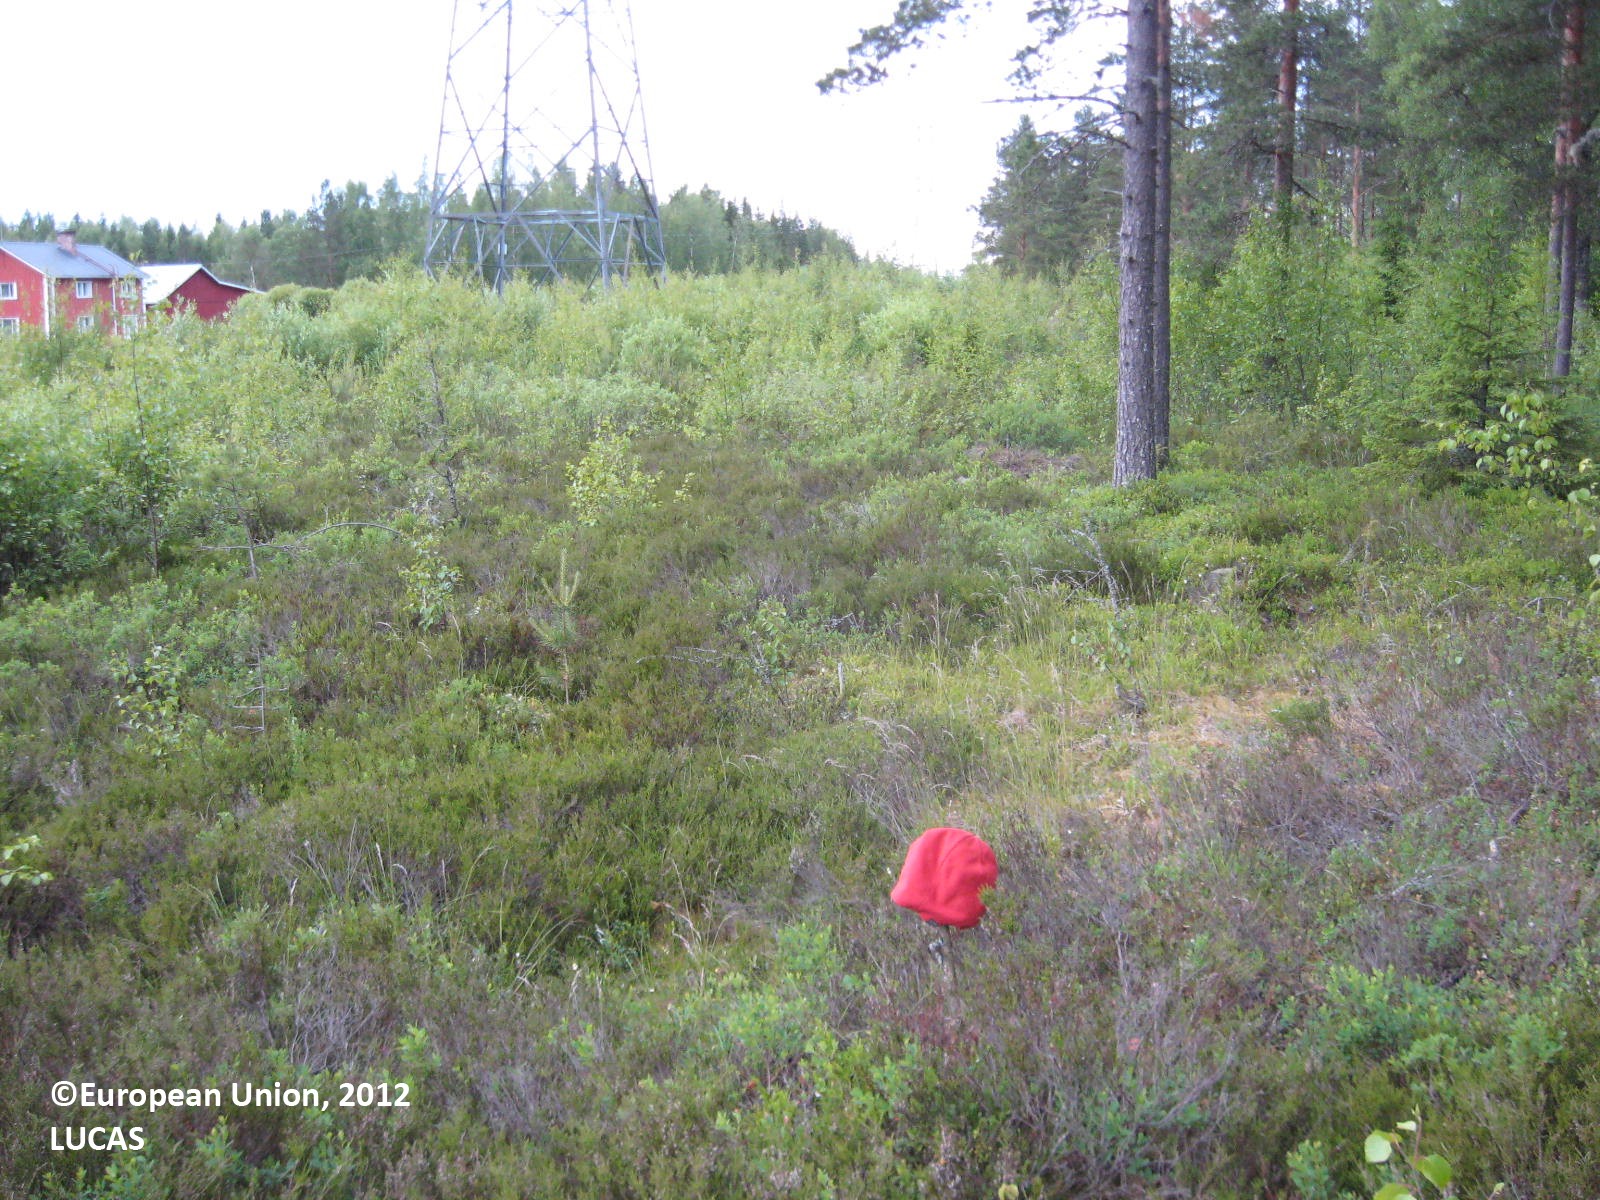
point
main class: Shrubland
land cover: Shrubland without tree cover
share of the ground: > 75 %
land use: Energy production
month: June
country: FI
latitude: 62.7371
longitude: 21.7262
